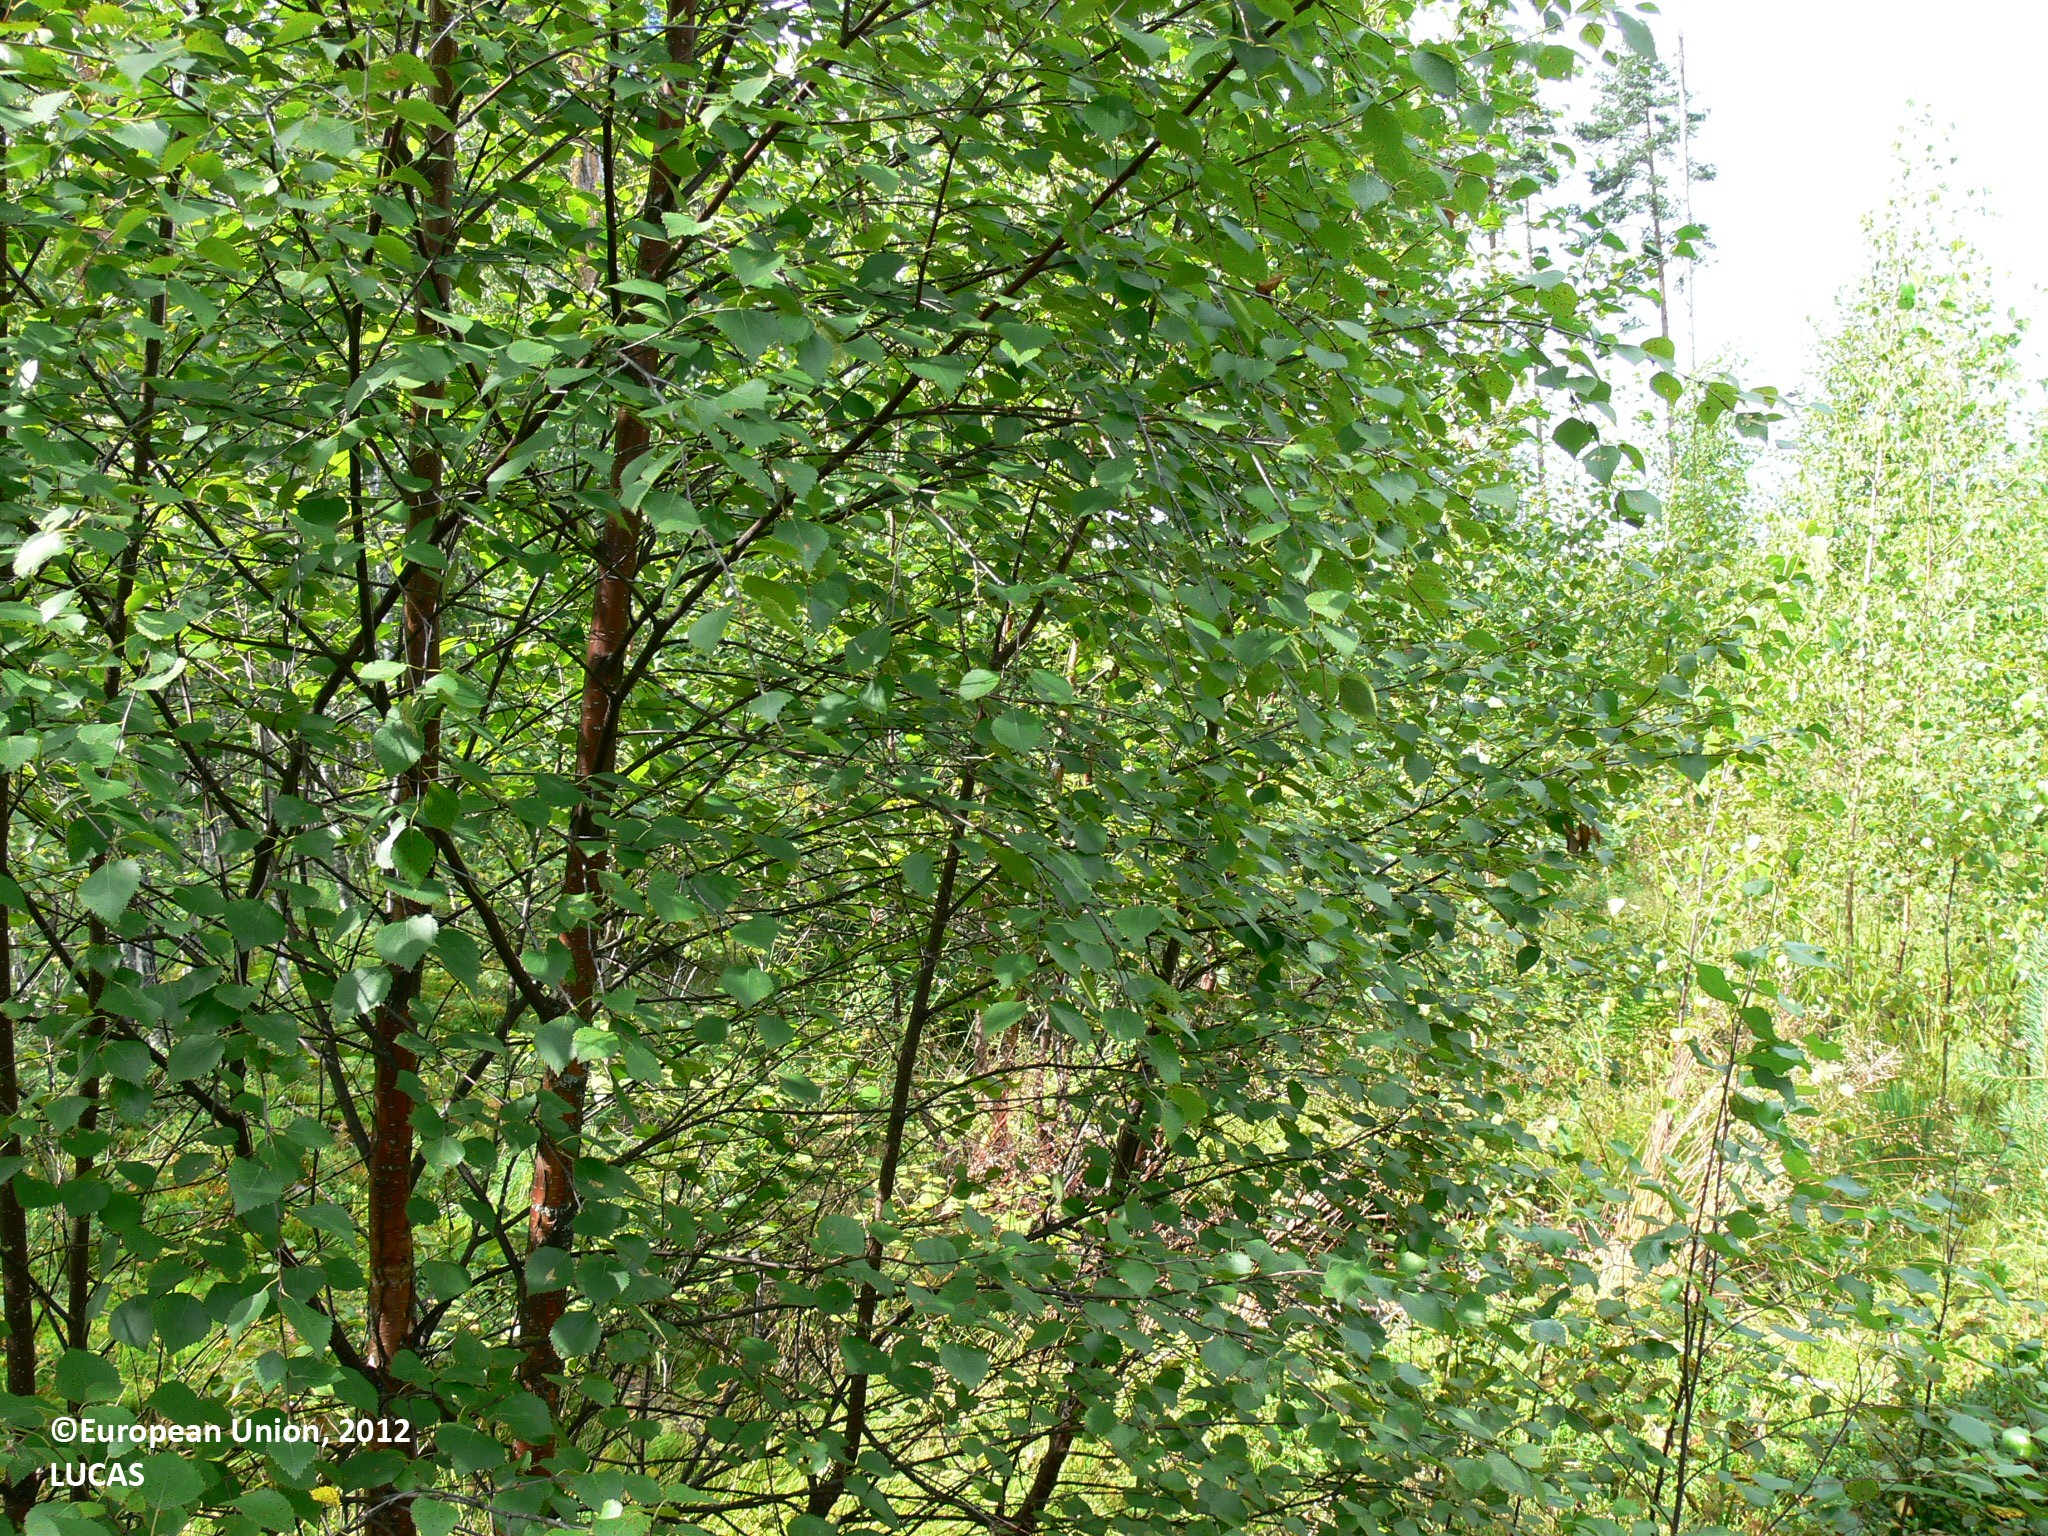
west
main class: Woodland
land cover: Broadleaved woodland
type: boreal forest
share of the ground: 50 - 75 %
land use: Forestry
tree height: < 5 m
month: August
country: FI
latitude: 61.8871
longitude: 29.2800
